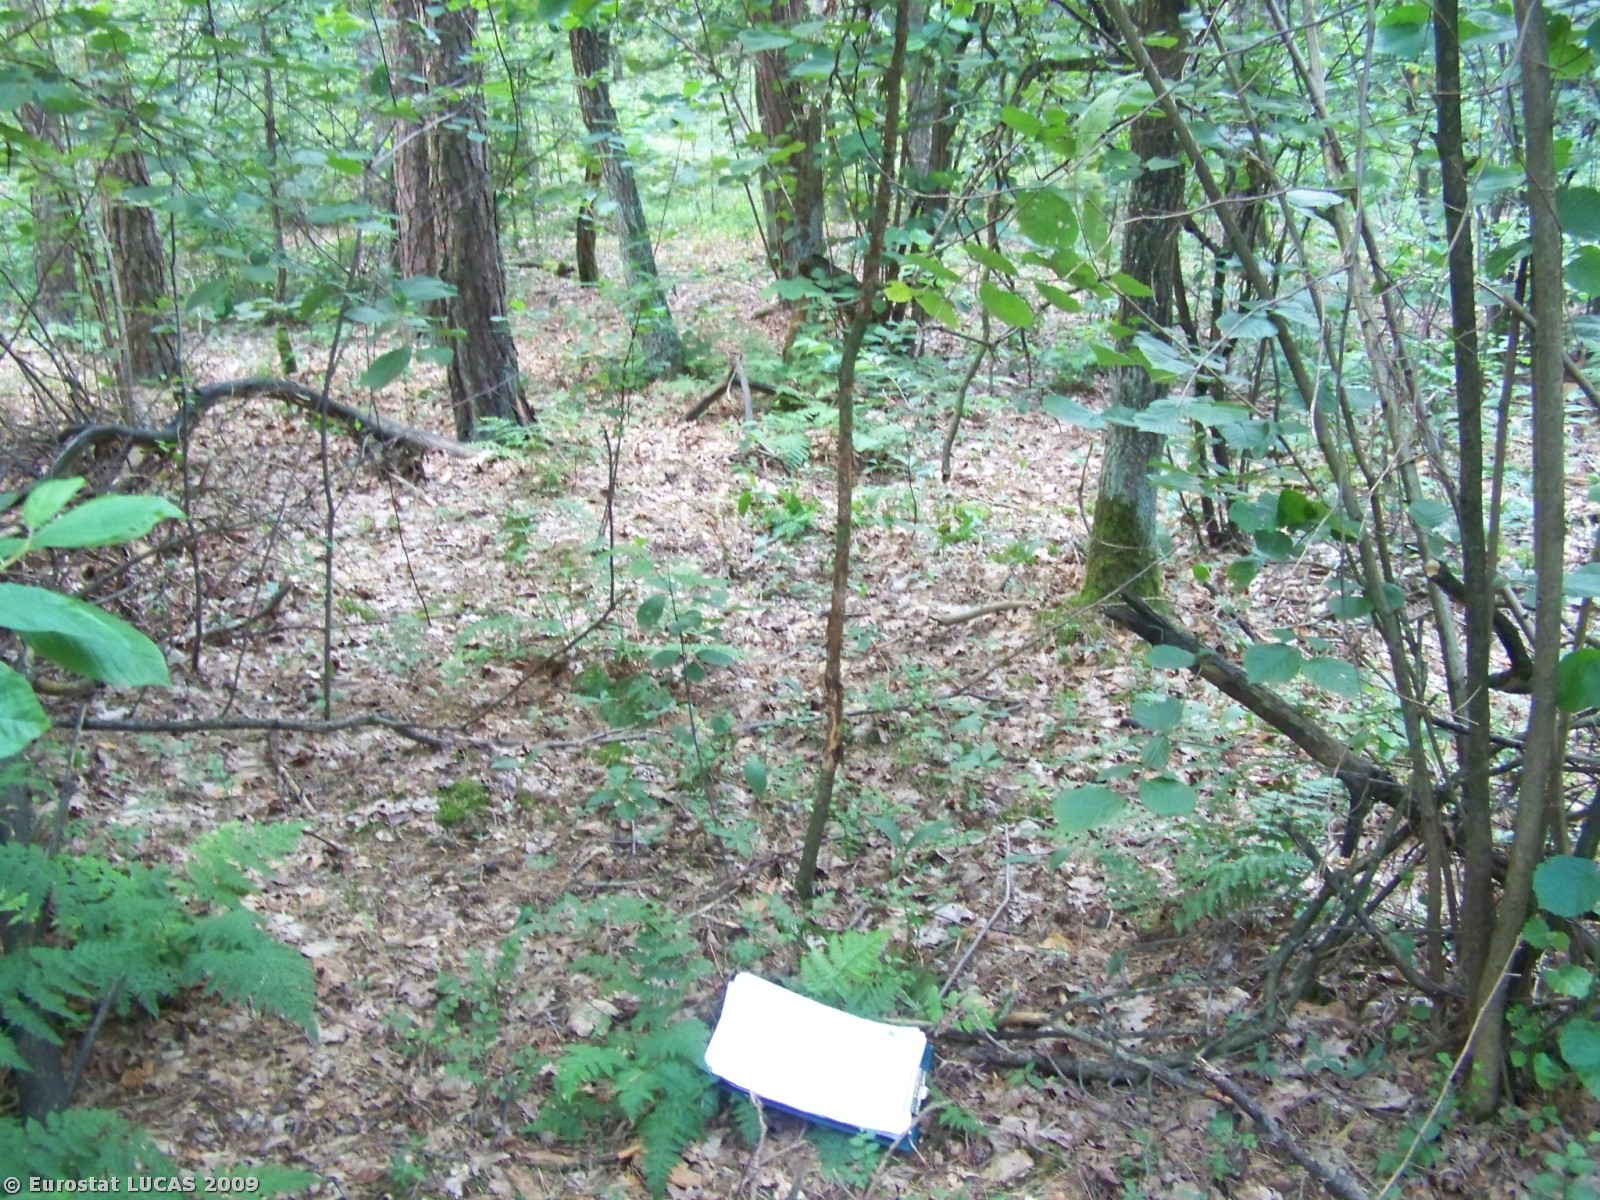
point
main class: Woodland
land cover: Coniferous woodland
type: hemiboreal forest and nemoral coniferous forest and mixed broadleaved-coniferous forest
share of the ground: > 75 %
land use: Forestry
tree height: > 5 m
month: July
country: PL
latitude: 51.4404
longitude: 21.9848
